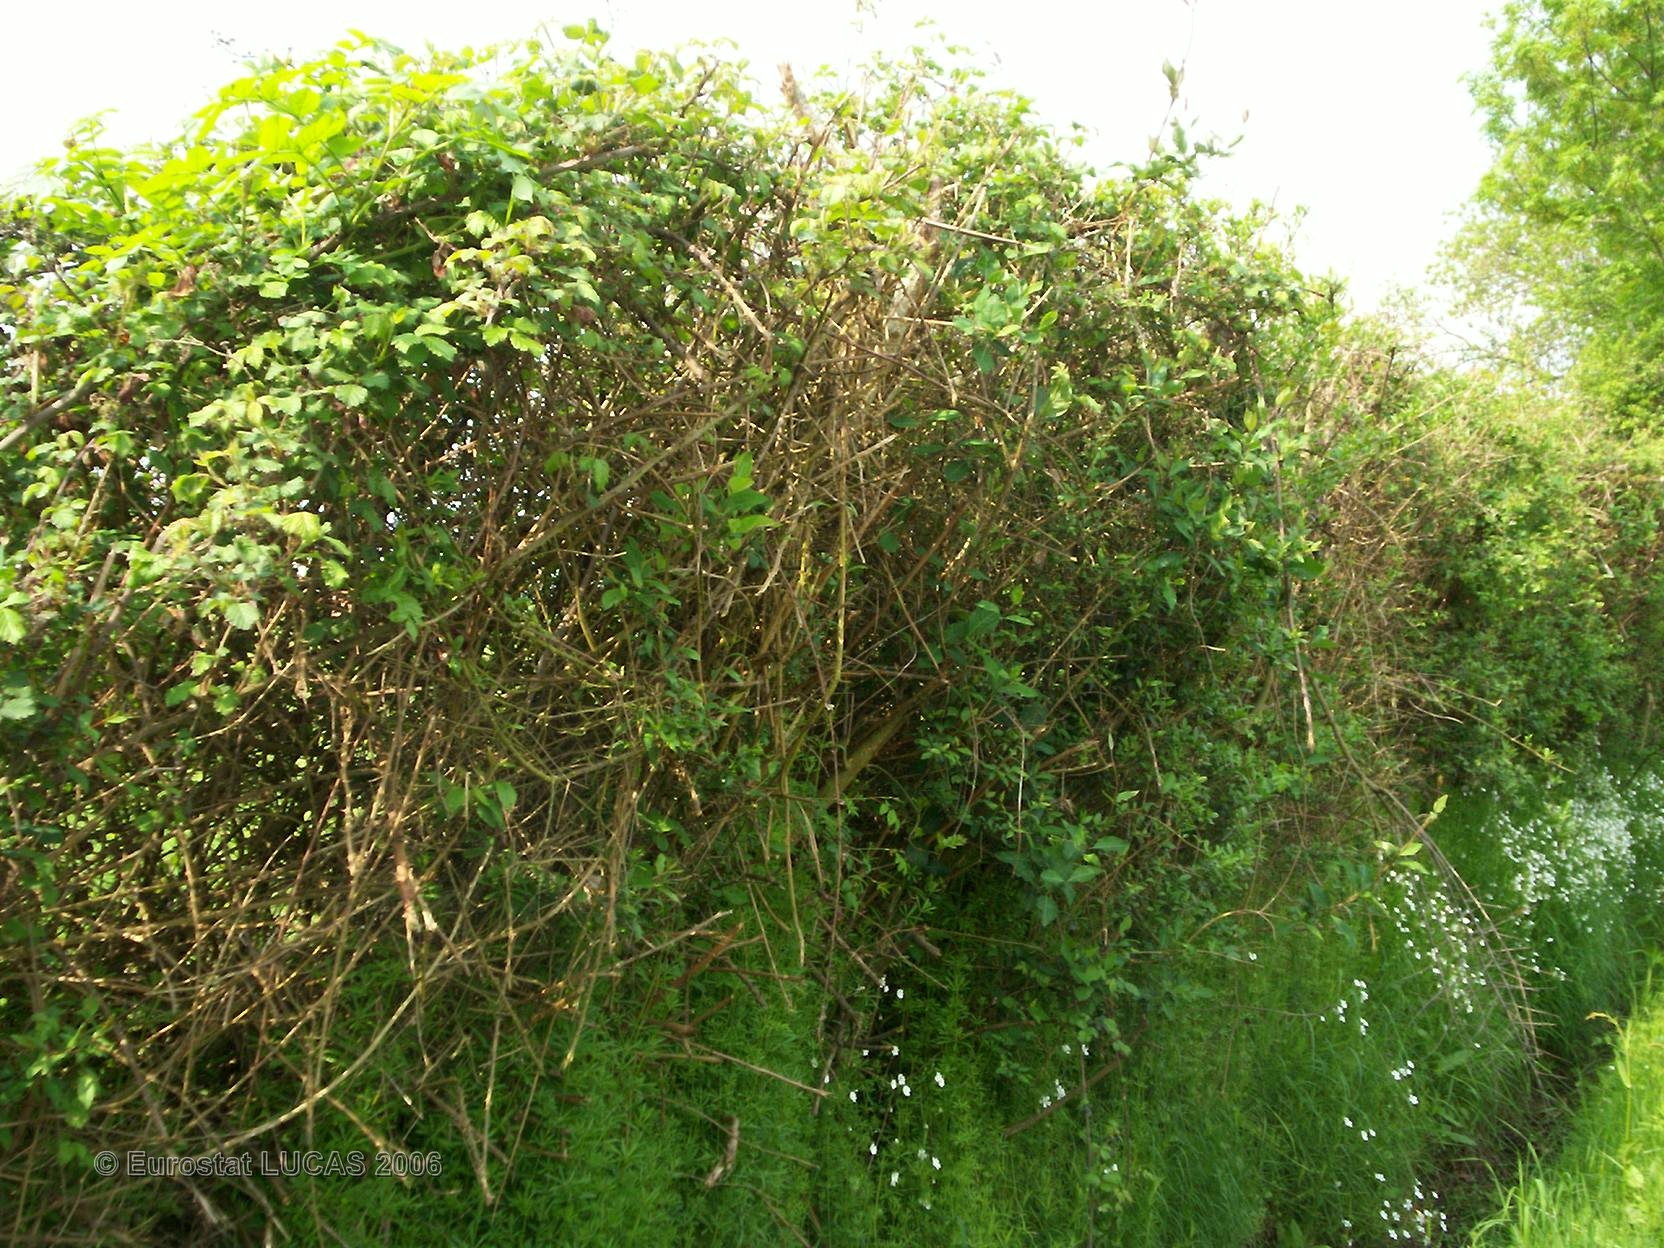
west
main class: Grassland
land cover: Grassland without tree/shrub cover
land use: Agriculture (excluding fallow land and kitchen gardens)
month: May
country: FR
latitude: 48.5096
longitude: 0.1855
